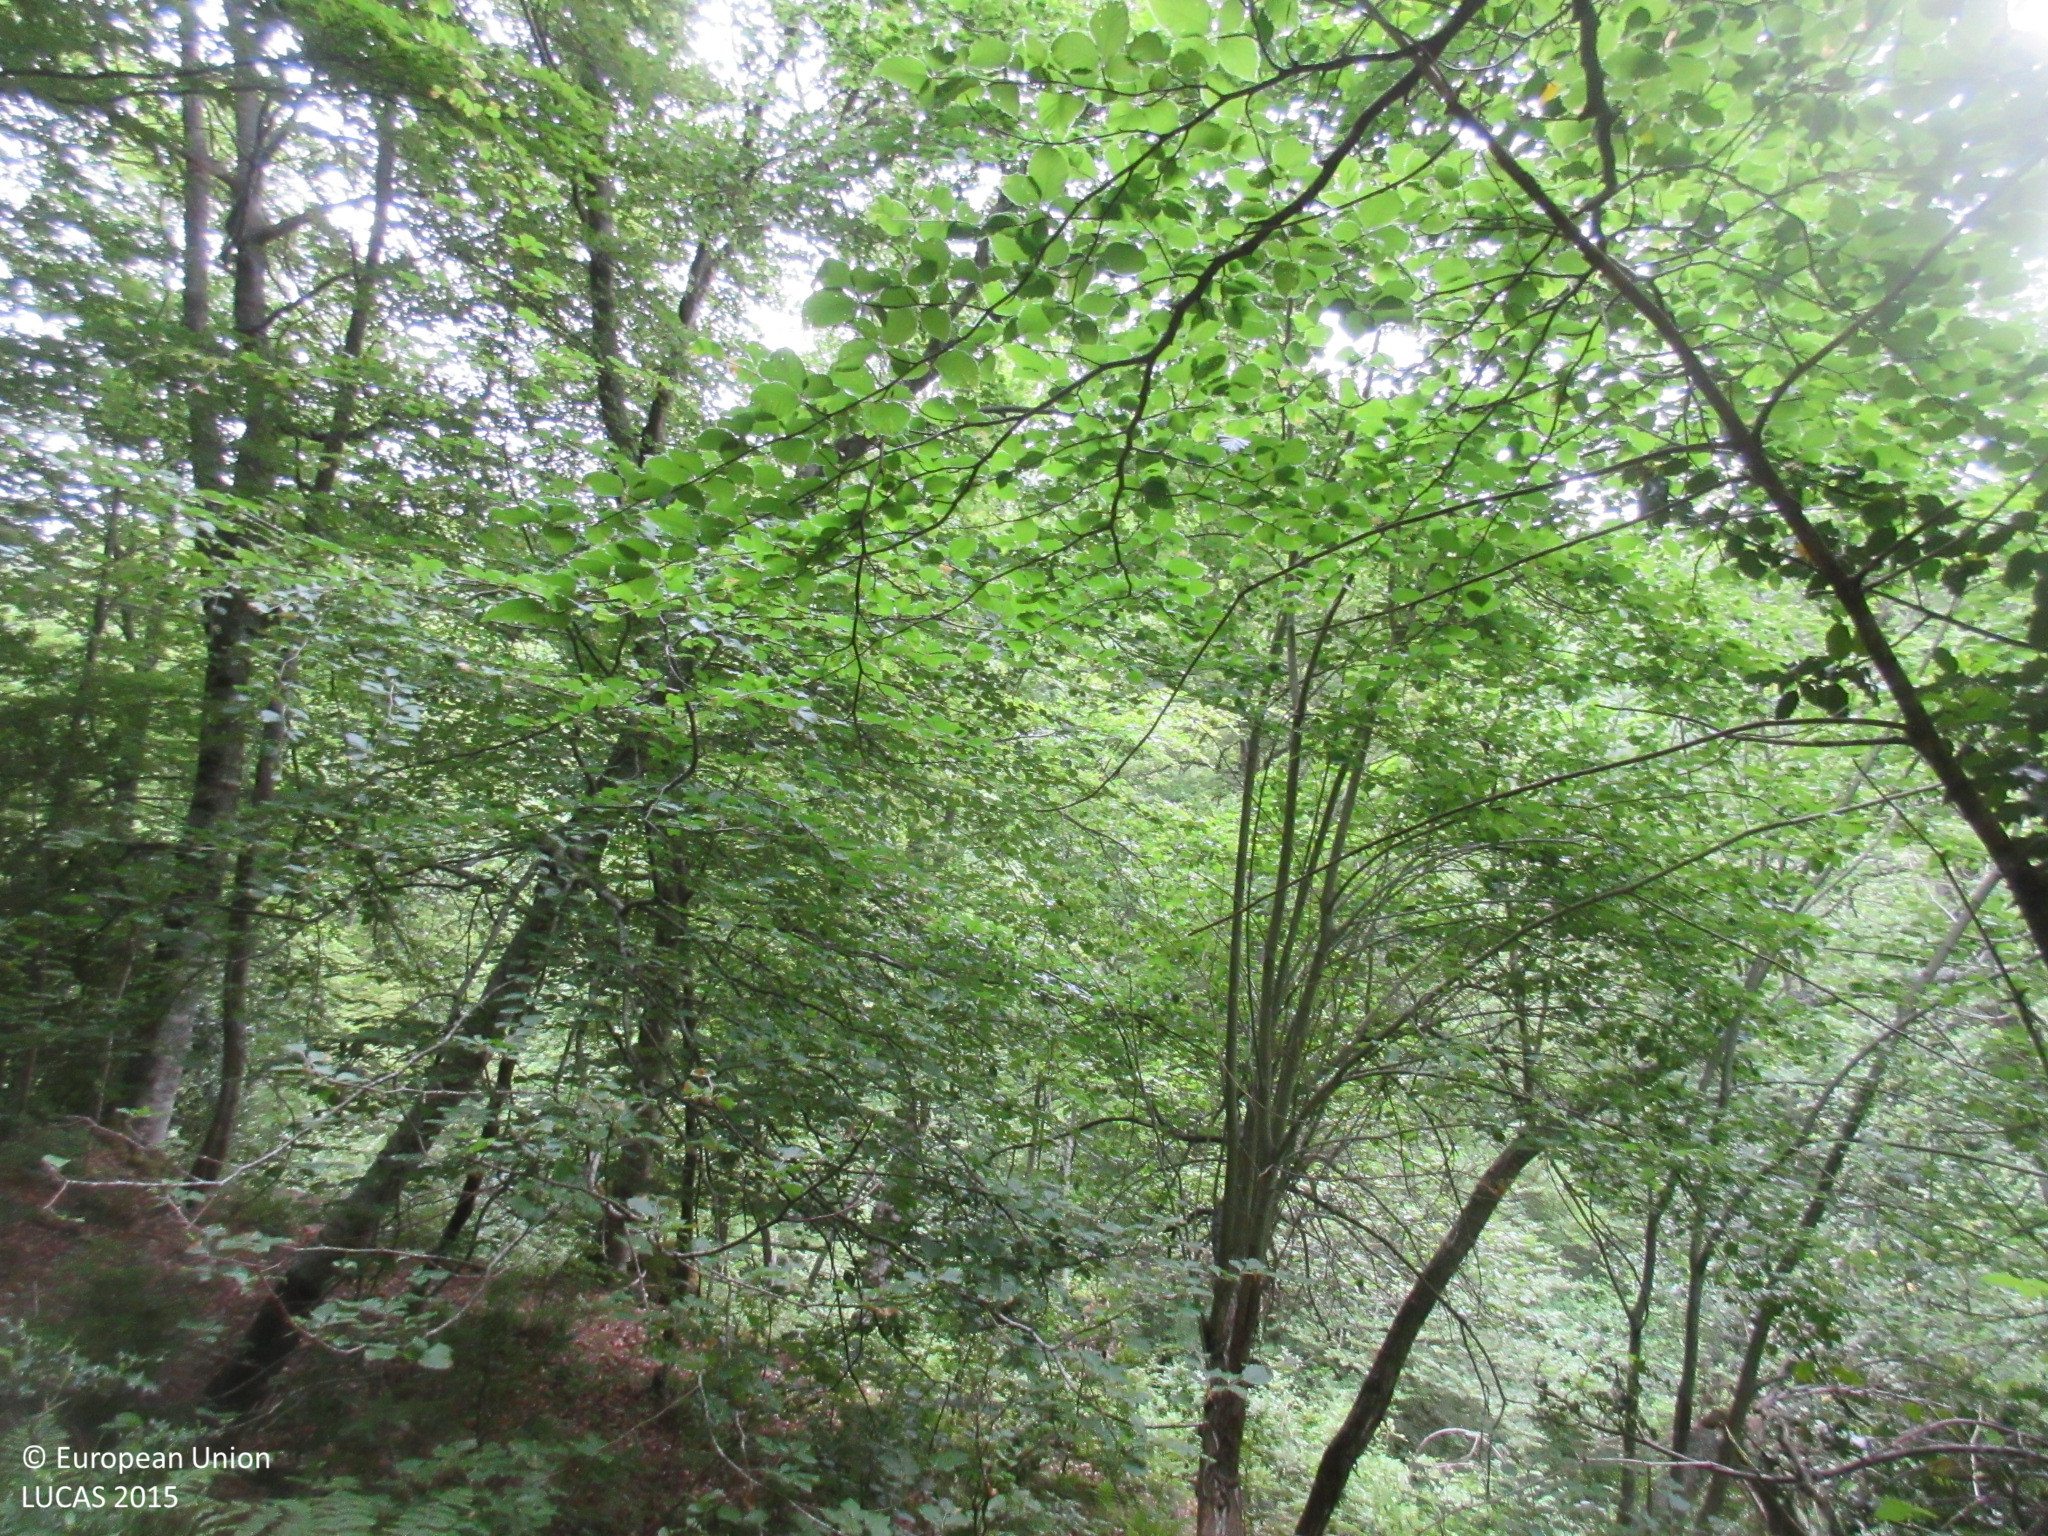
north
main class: Woodland
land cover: Broadleaved woodland
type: beech forest
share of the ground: > 75 %
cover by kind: broadleaved forest trees 95 %, shrubs 5 %
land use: Semi-natural and natural areas not in use
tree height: > 5 m
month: June
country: ES
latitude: 43.0713
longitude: -4.4871
